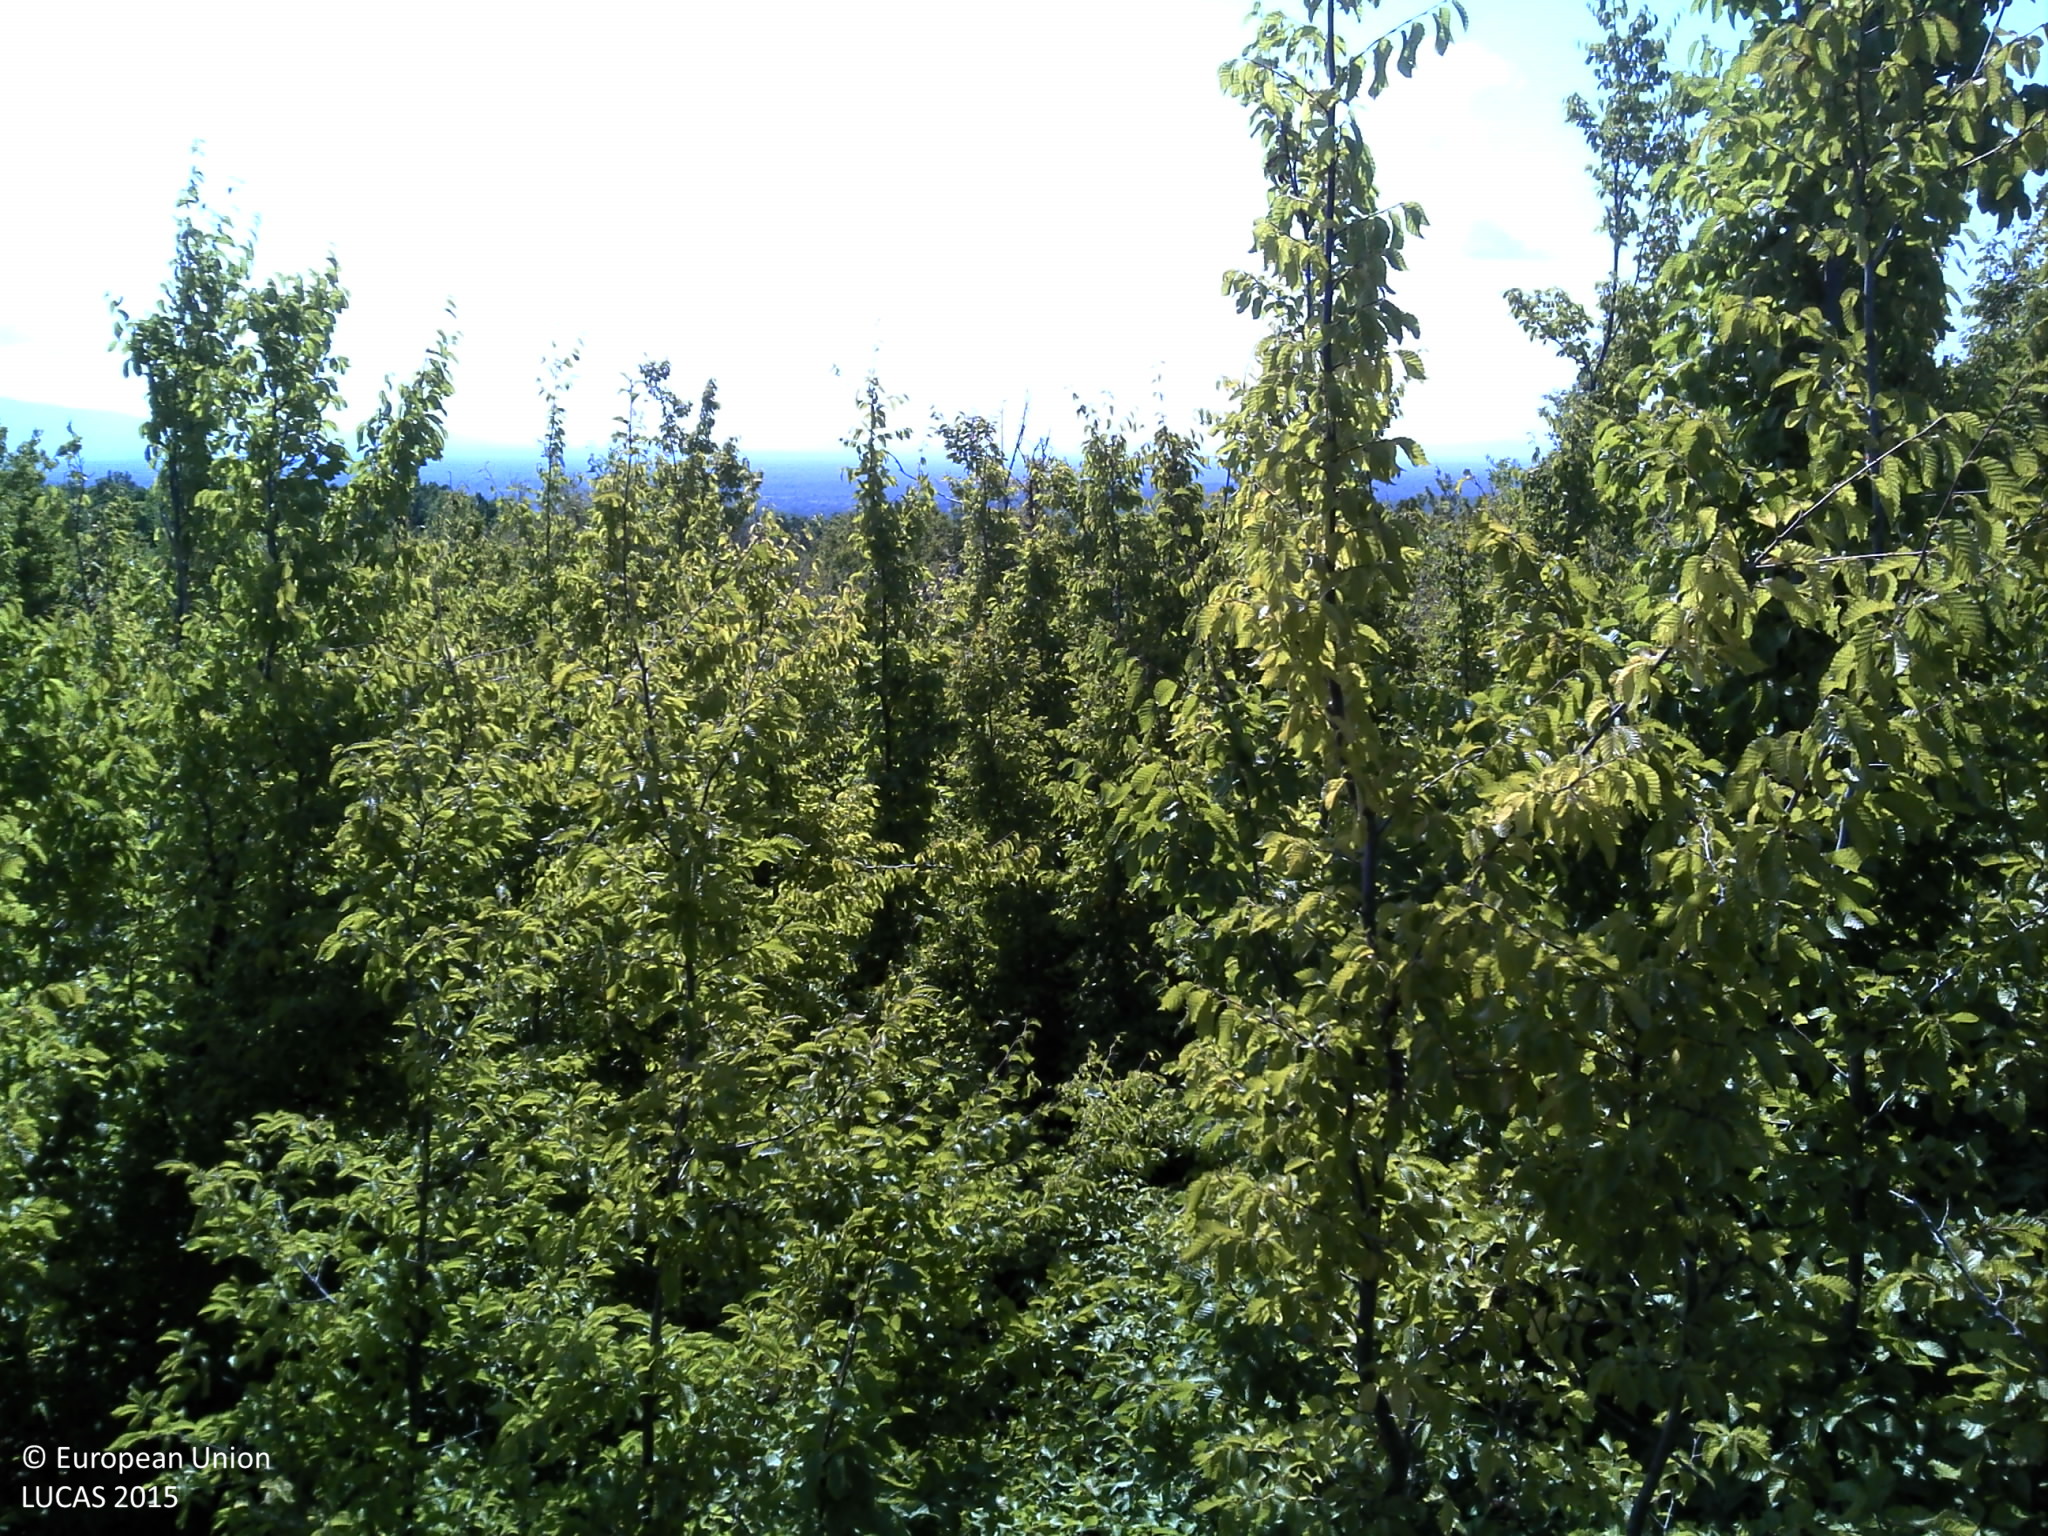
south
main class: Woodland
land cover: Broadleaved woodland
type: thermophilous deciduous forest
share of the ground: > 75 %
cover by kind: shrubs 40 %, broadleaved forest trees 30 %, herbaceous plants 10 %, consolidated bare surface 10 %, unconsolidated bare surface 10 %
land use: Semi-natural and natural areas not in use
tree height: > 5 m
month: August
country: HR
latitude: 44.0743
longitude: 15.8984
